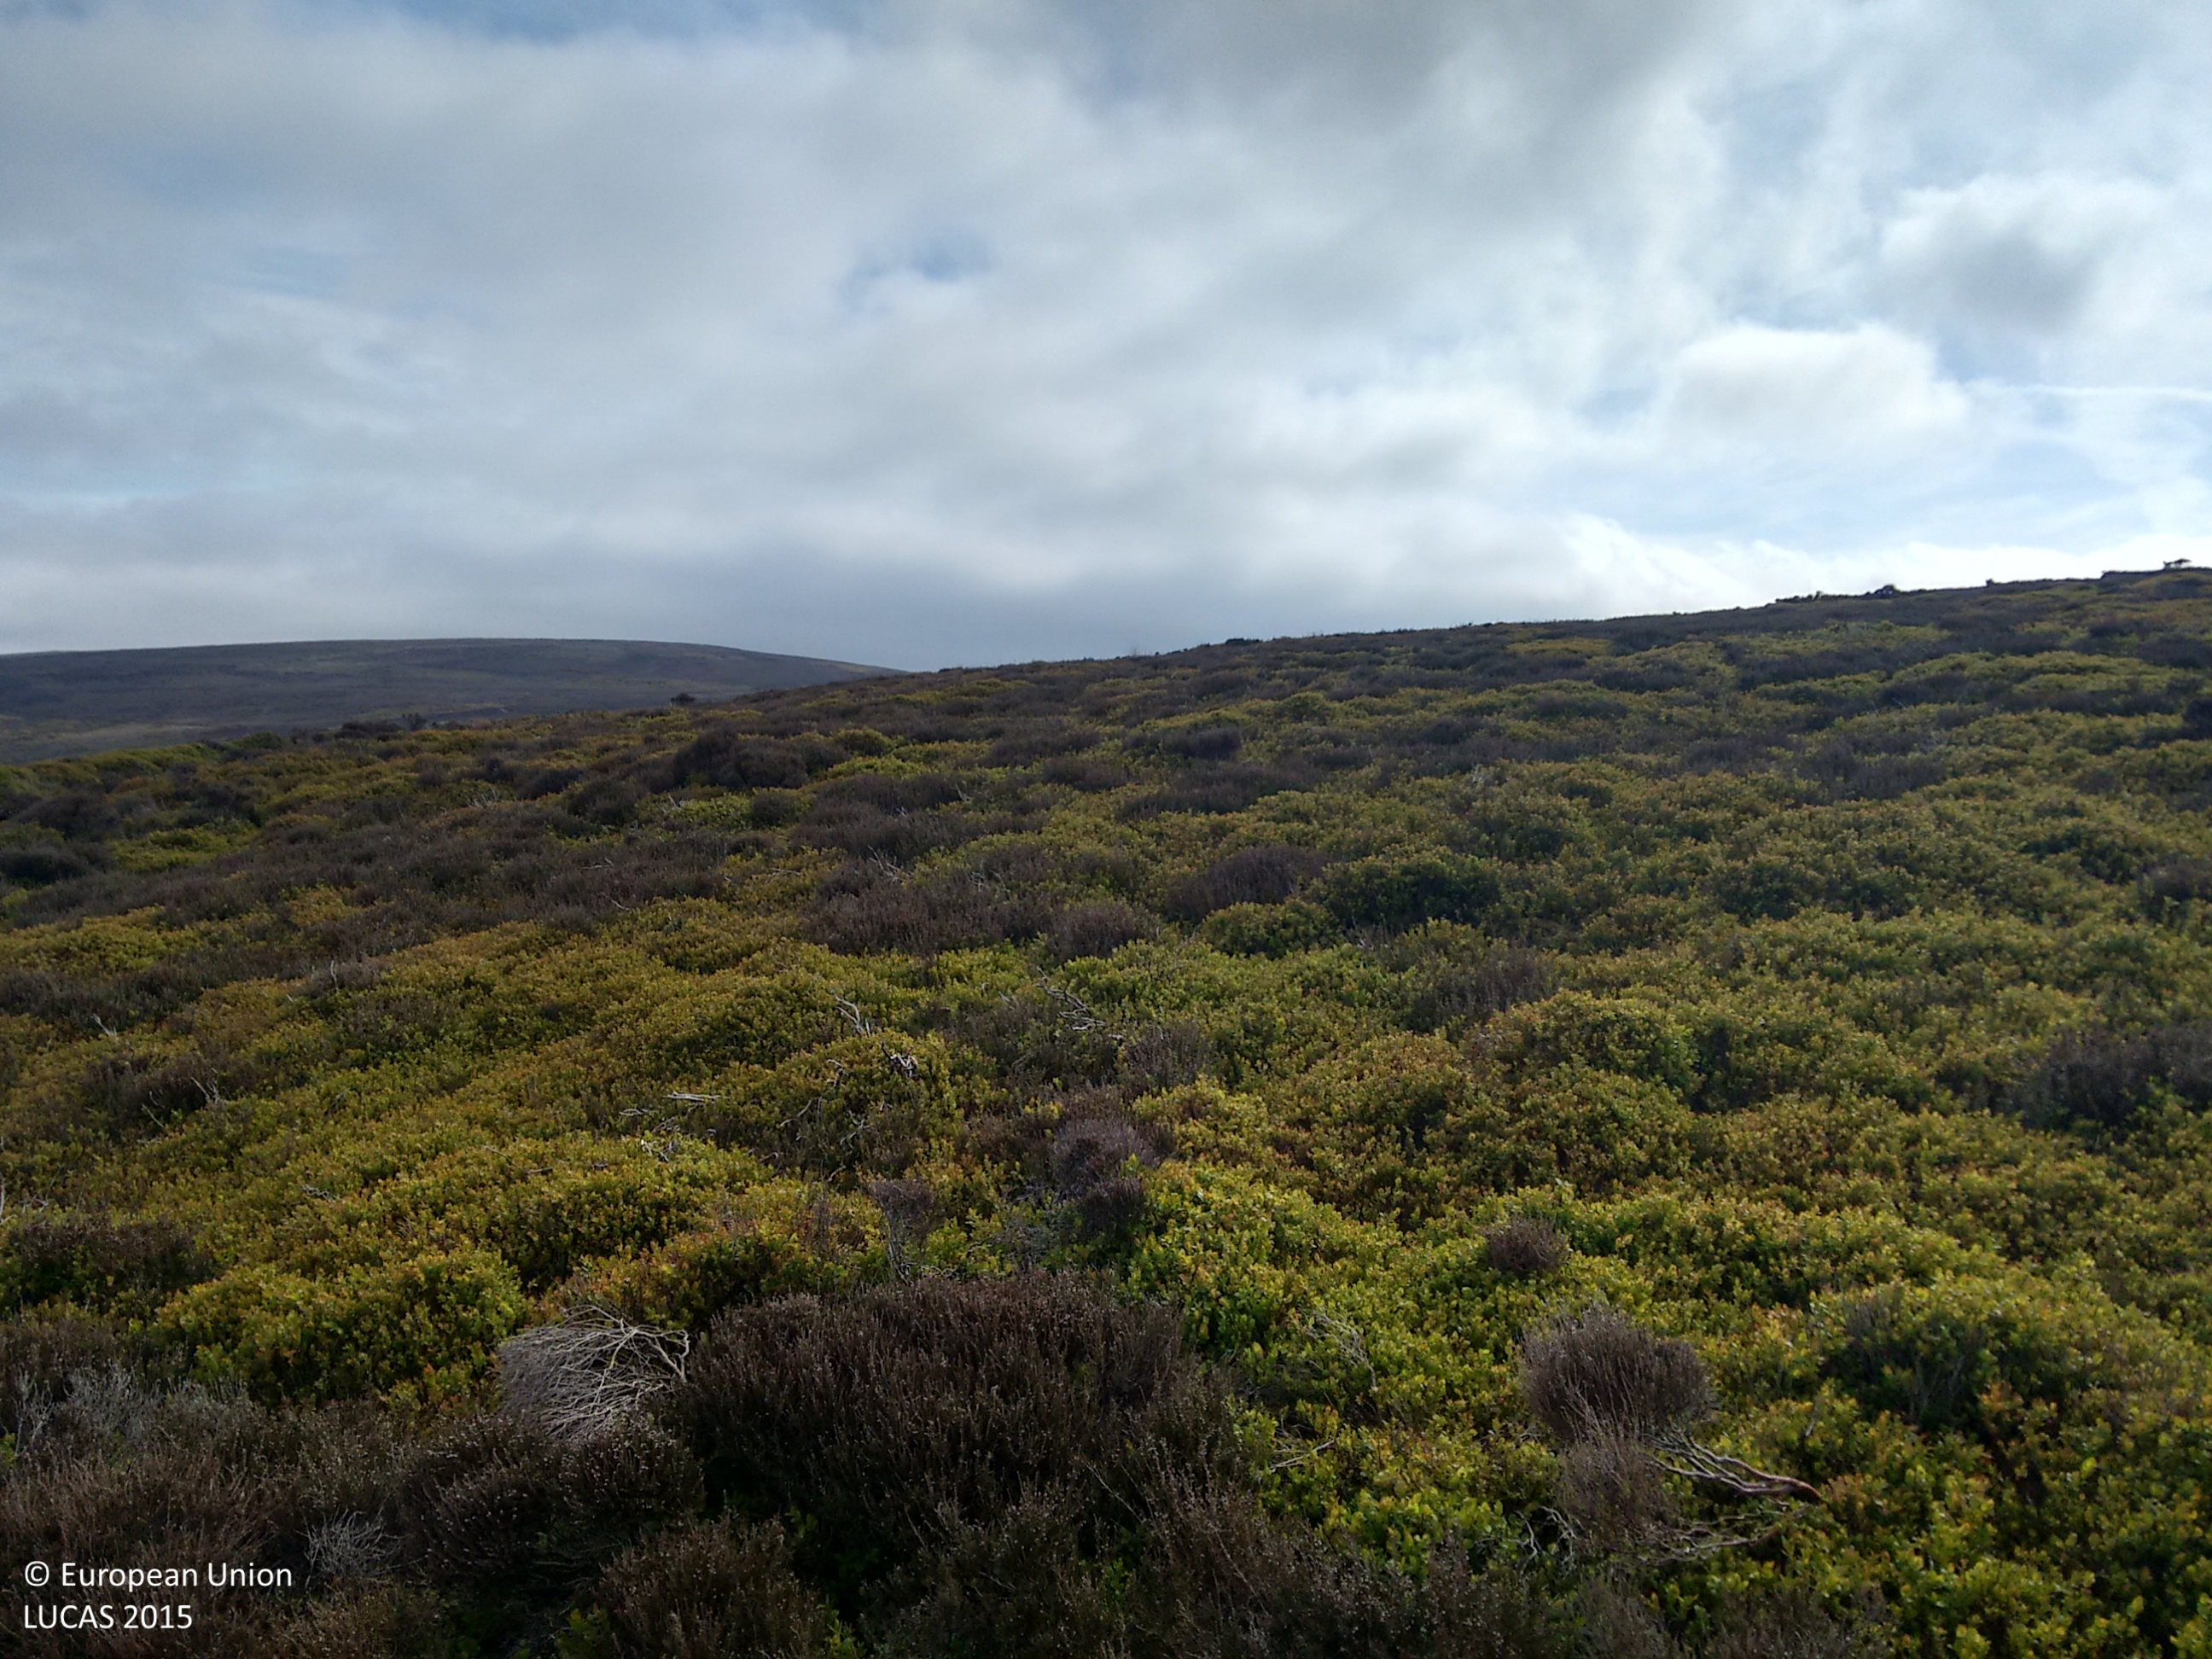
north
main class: Shrubland
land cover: Shrubland without tree cover
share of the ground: > 75 %
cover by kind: shrubs 100 %
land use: Agriculture (excluding fallow land and kitchen gardens)
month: May
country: GB
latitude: 53.9148
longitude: -2.6892
